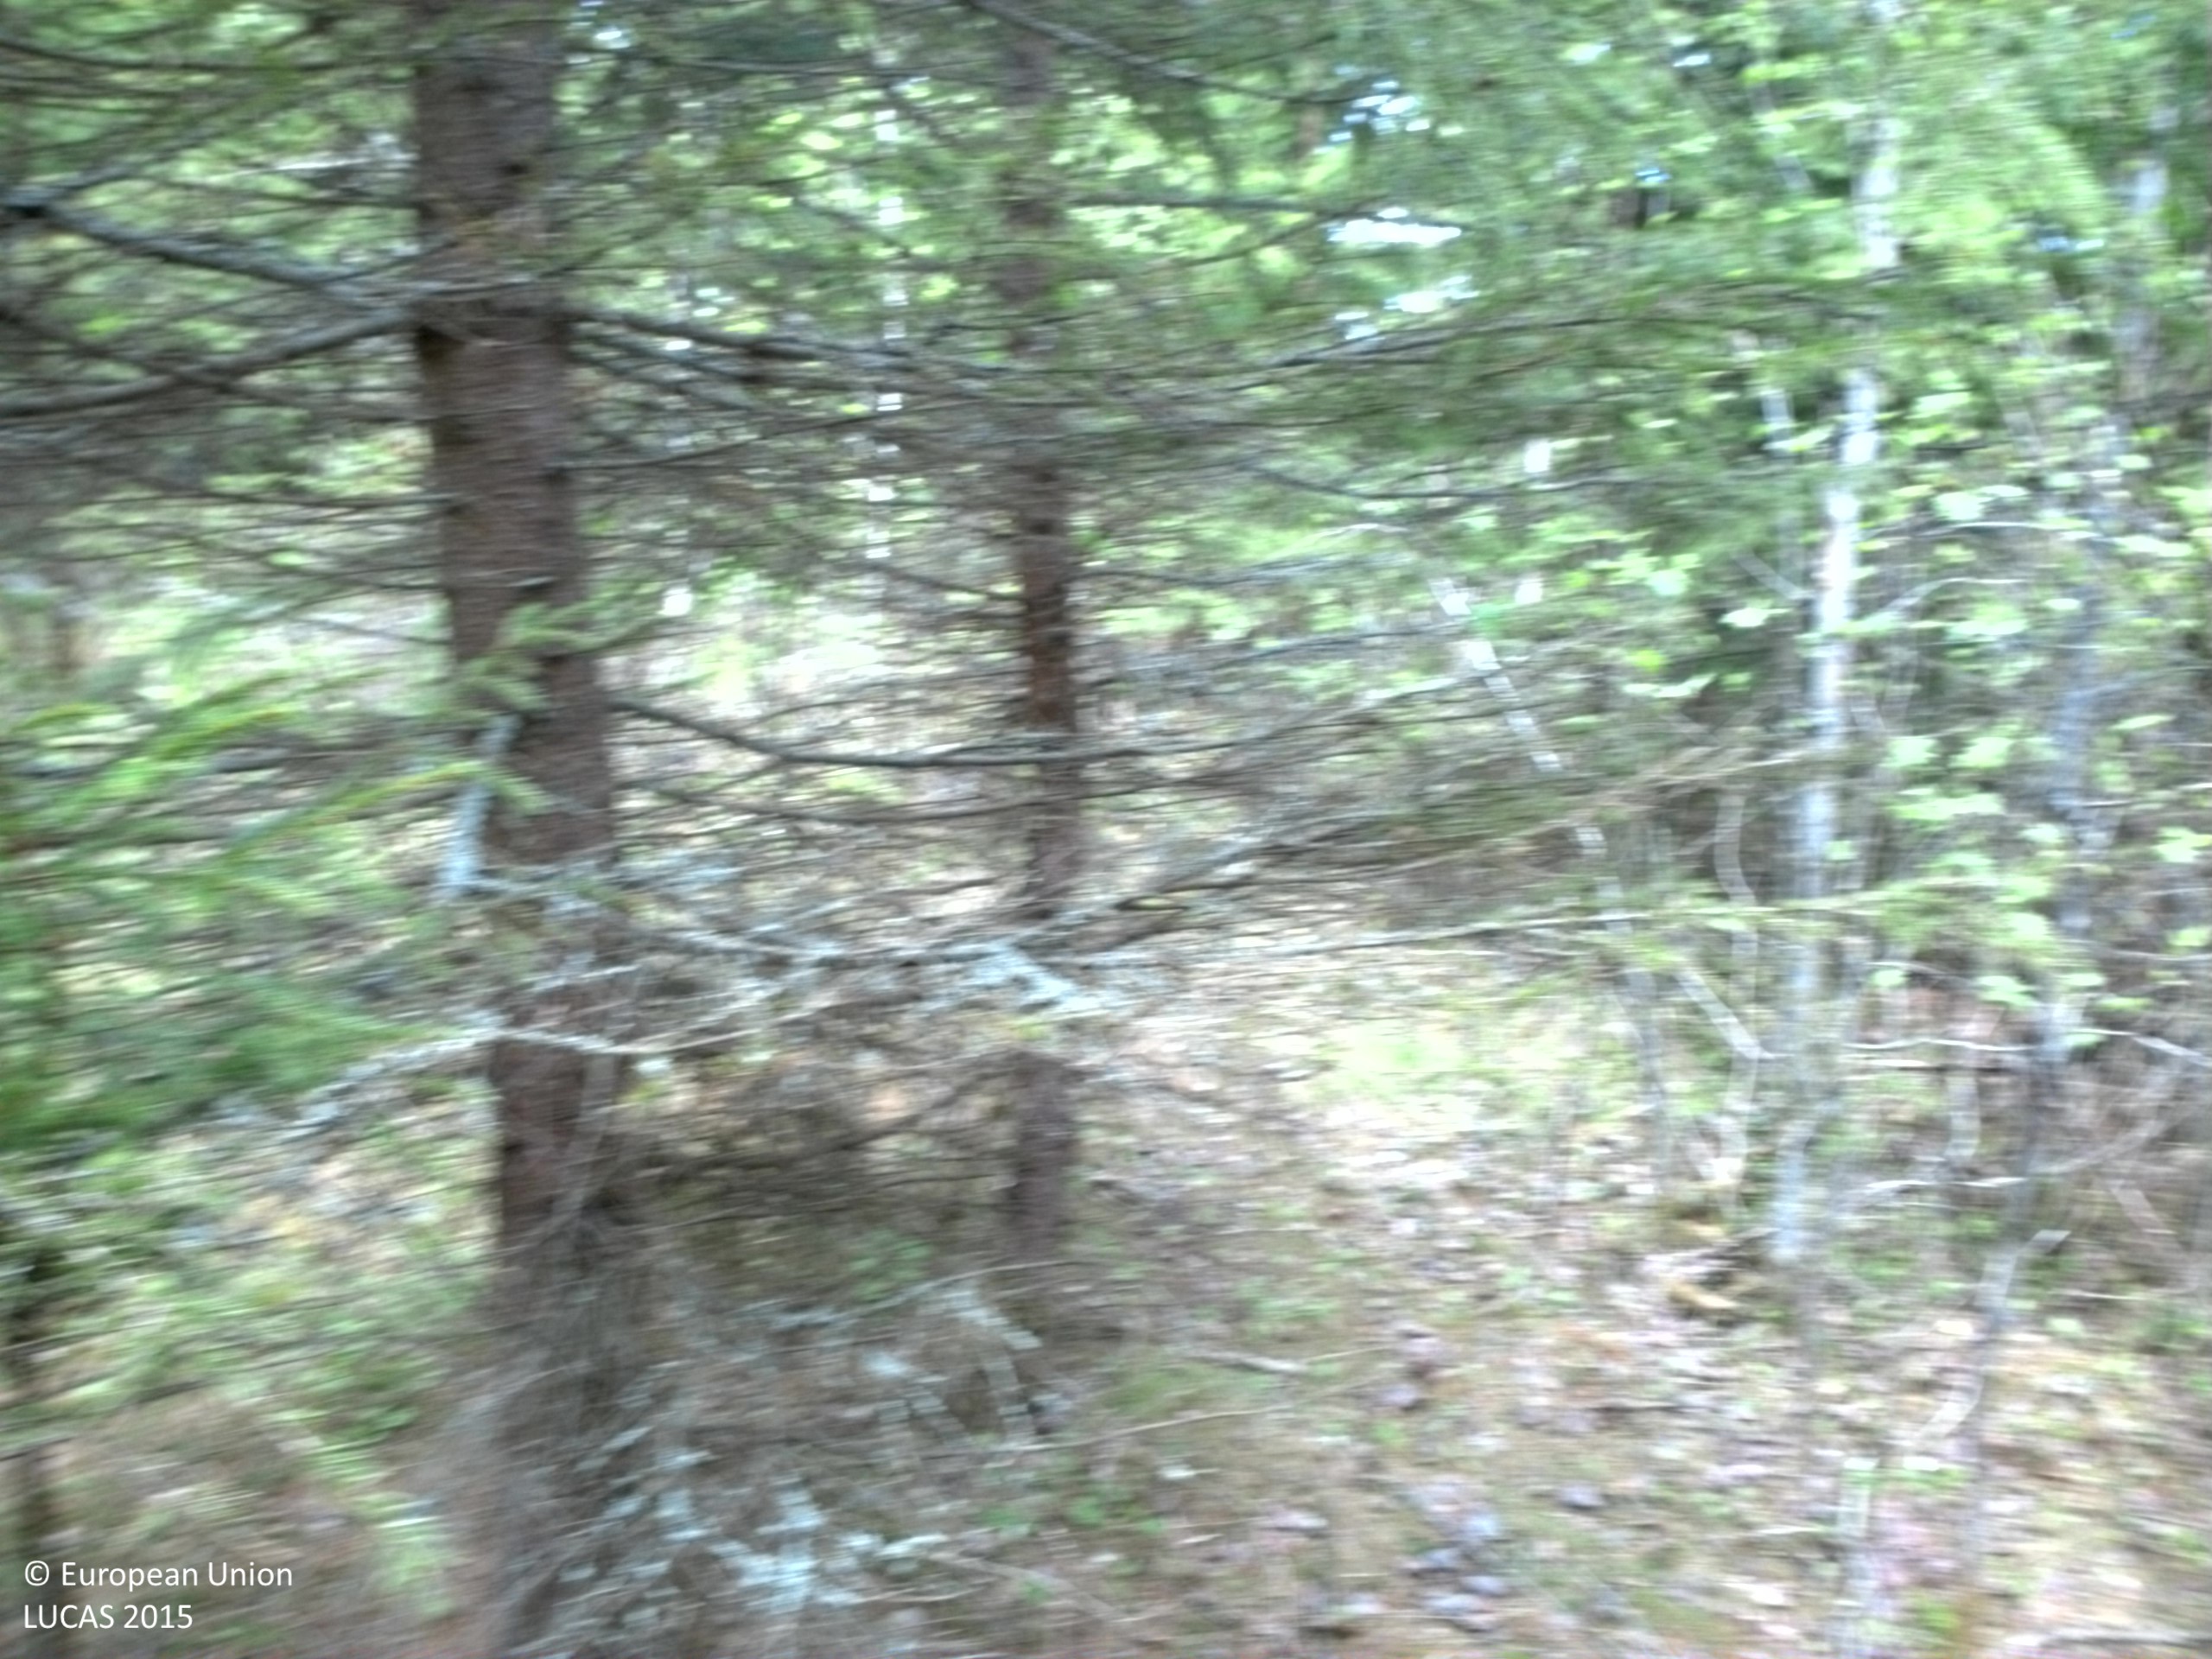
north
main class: Woodland
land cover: Spruce dominated coniferous woodland
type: boreal forest
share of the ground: > 75 %
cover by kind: coniferous forest trees 75 %, lichens and mosses 15 %, shrubs 10 %
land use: Forestry
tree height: > 5 m
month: May
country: SE
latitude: 62.8742
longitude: 17.9408
